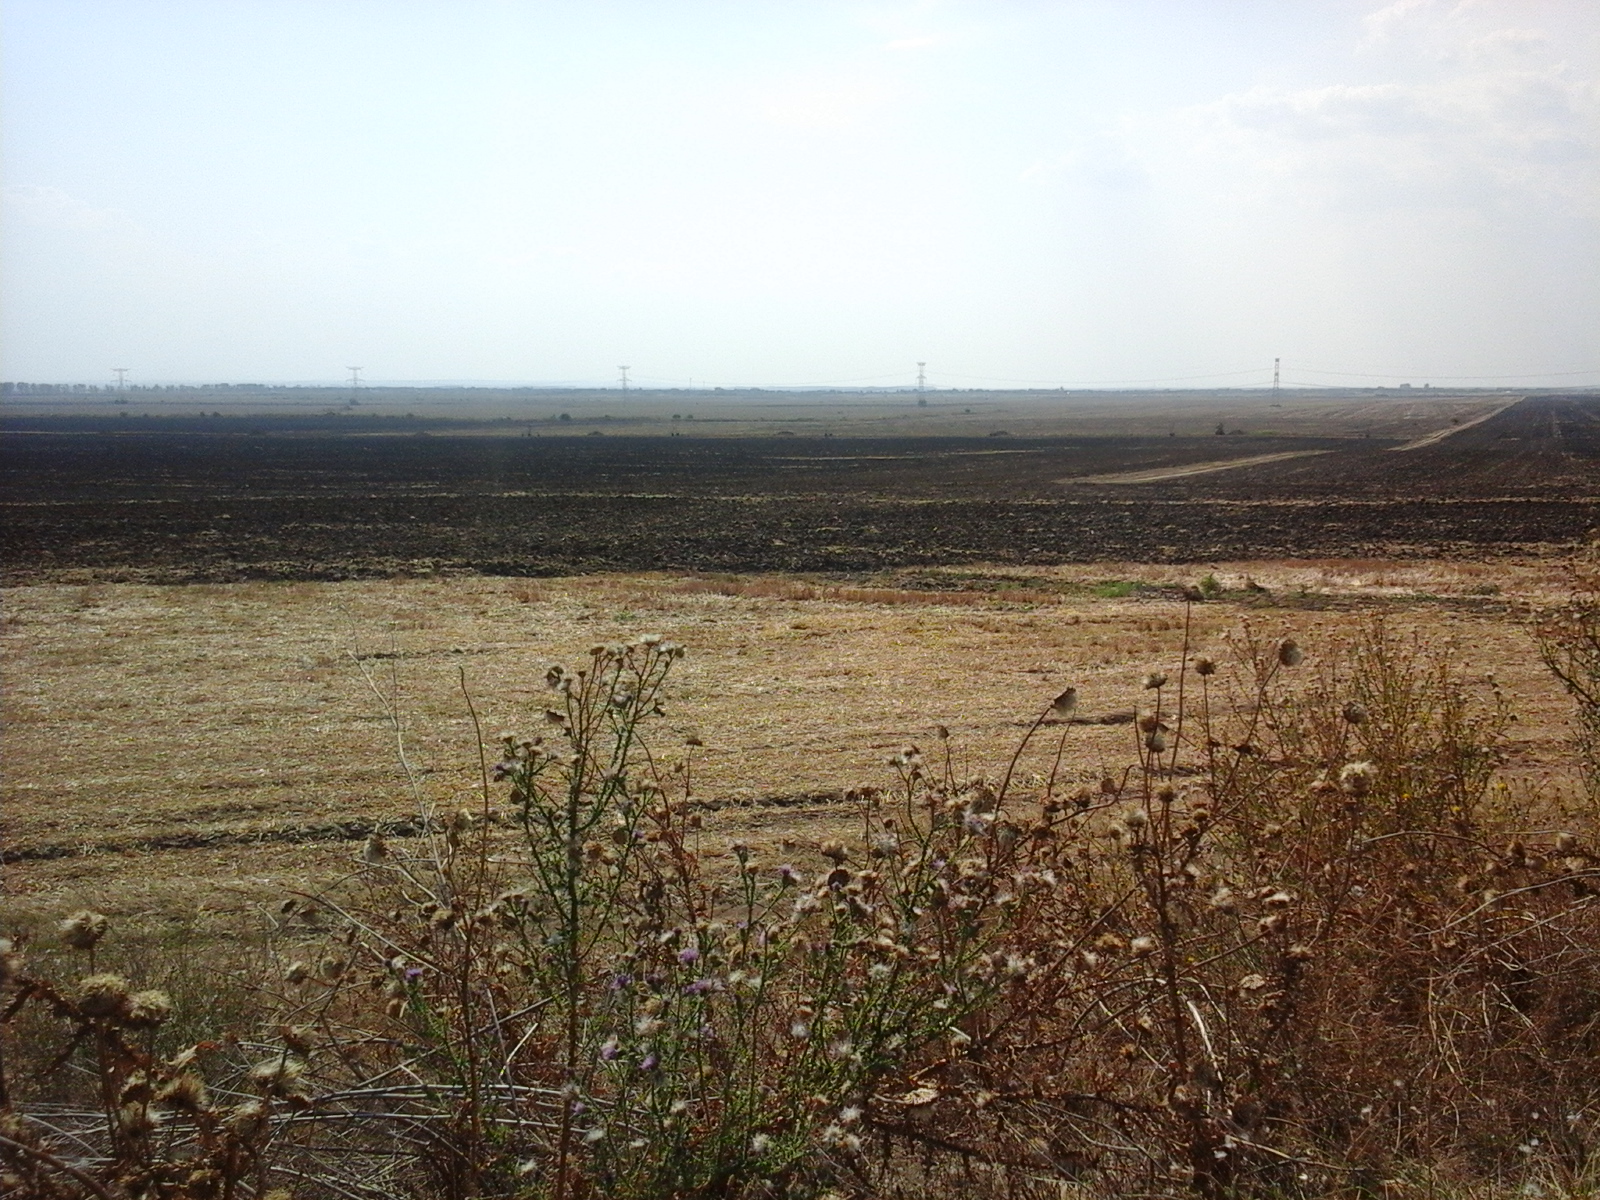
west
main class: Cropland
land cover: Maize
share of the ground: > 75 %
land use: Agriculture (excluding fallow land and kitchen gardens)
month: August
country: RO
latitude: 43.9348
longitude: 23.6670
